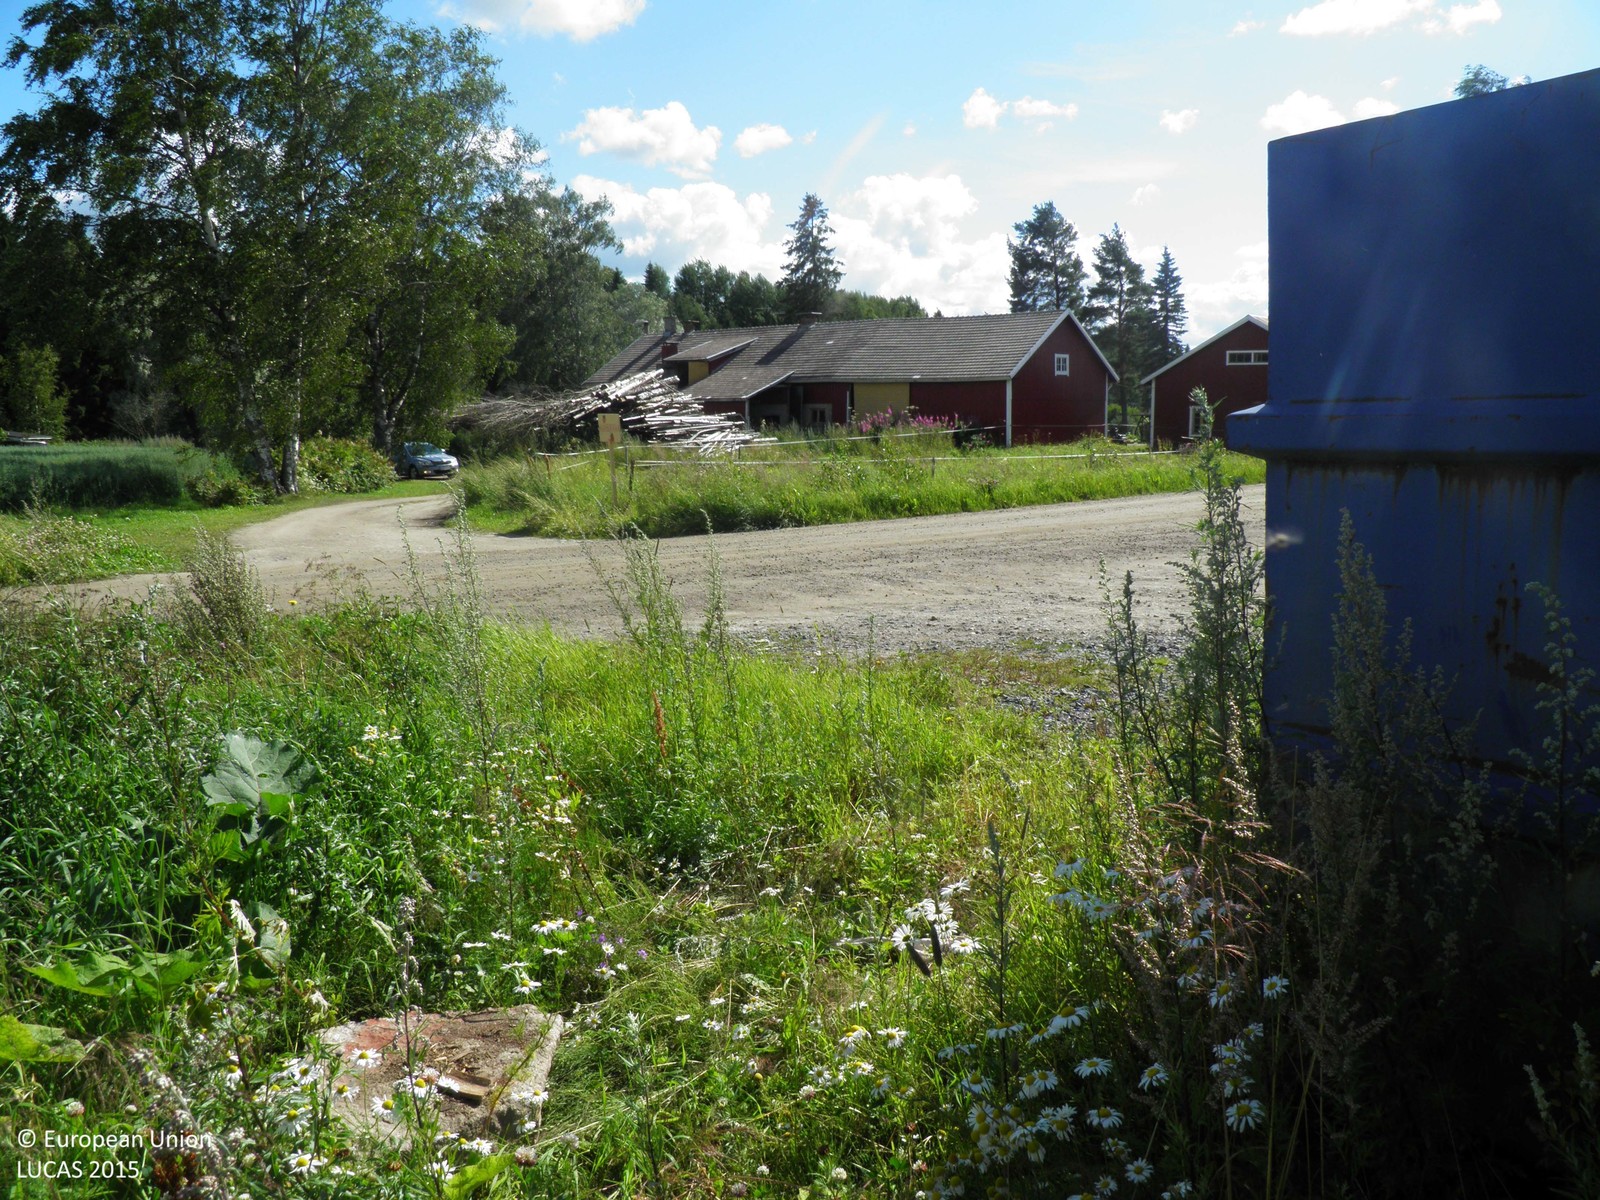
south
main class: Shrubland
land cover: Shrubland without tree cover
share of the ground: > 75 %
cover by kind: shrubs 100 %
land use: Agriculture (excluding fallow land and kitchen gardens)
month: August
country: FI
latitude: 60.9746
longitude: 23.1022
